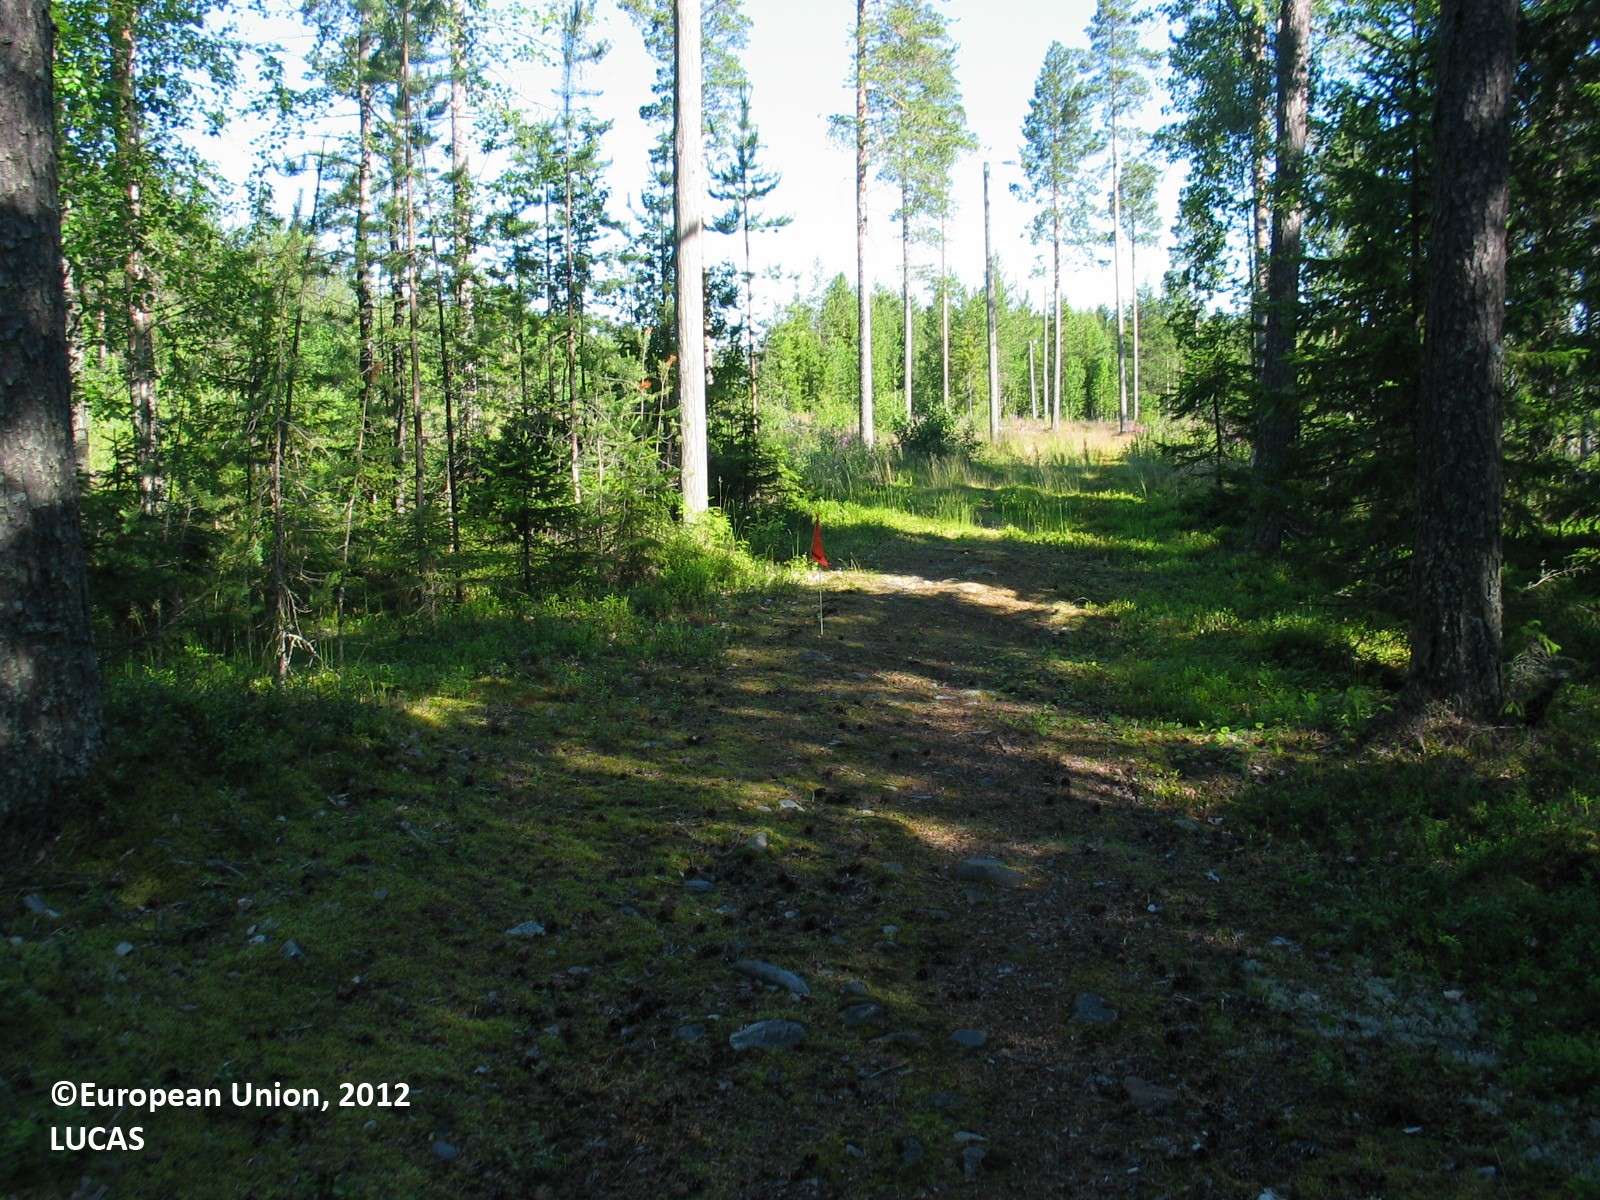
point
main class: Woodland
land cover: Other mixed woodland
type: boreal forest
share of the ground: 50 - 75 %
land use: Forestry
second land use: Sport
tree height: > 5 m
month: July
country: FI
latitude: 65.6598
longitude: 24.9589
